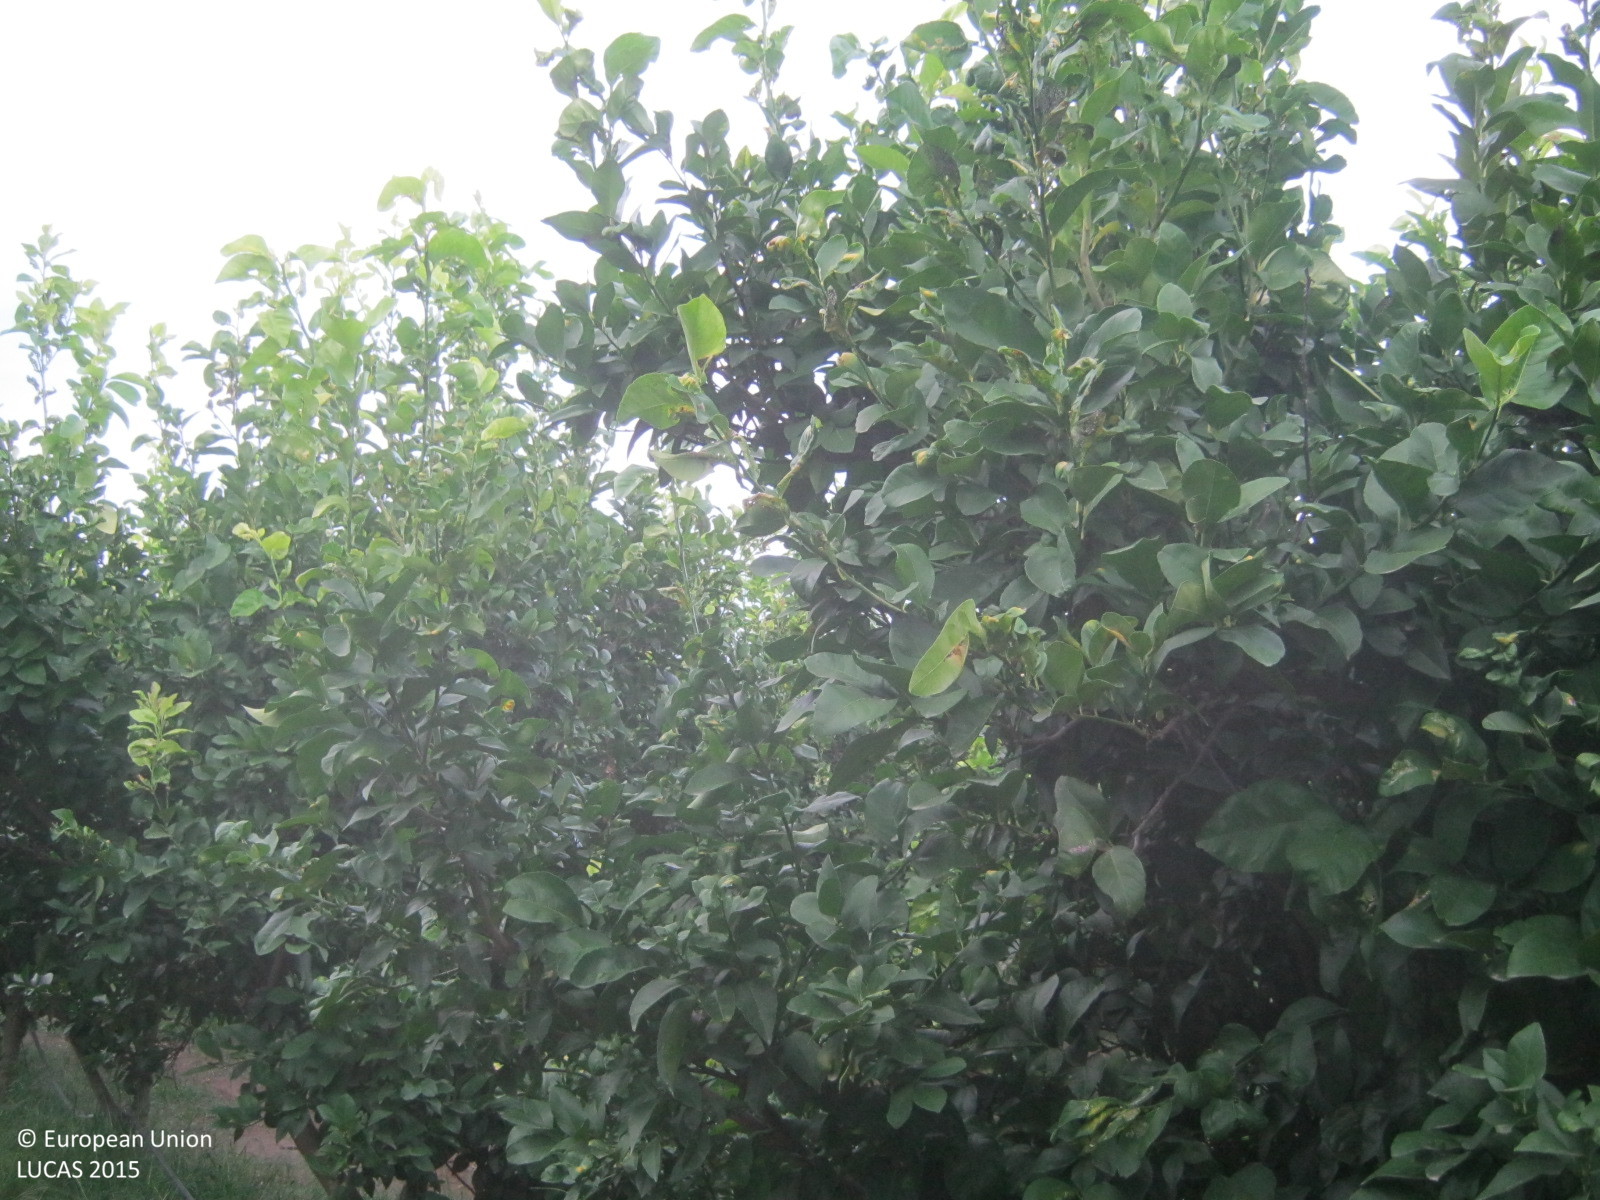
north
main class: Cropland
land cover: Other citrus fruit
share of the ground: 50 - 75 %
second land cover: Spontaneously vegetated surfaces
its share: > 75 %
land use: Agriculture (excluding fallow land and kitchen gardens)
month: September
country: GR
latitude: 38.2306
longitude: 22.1363
